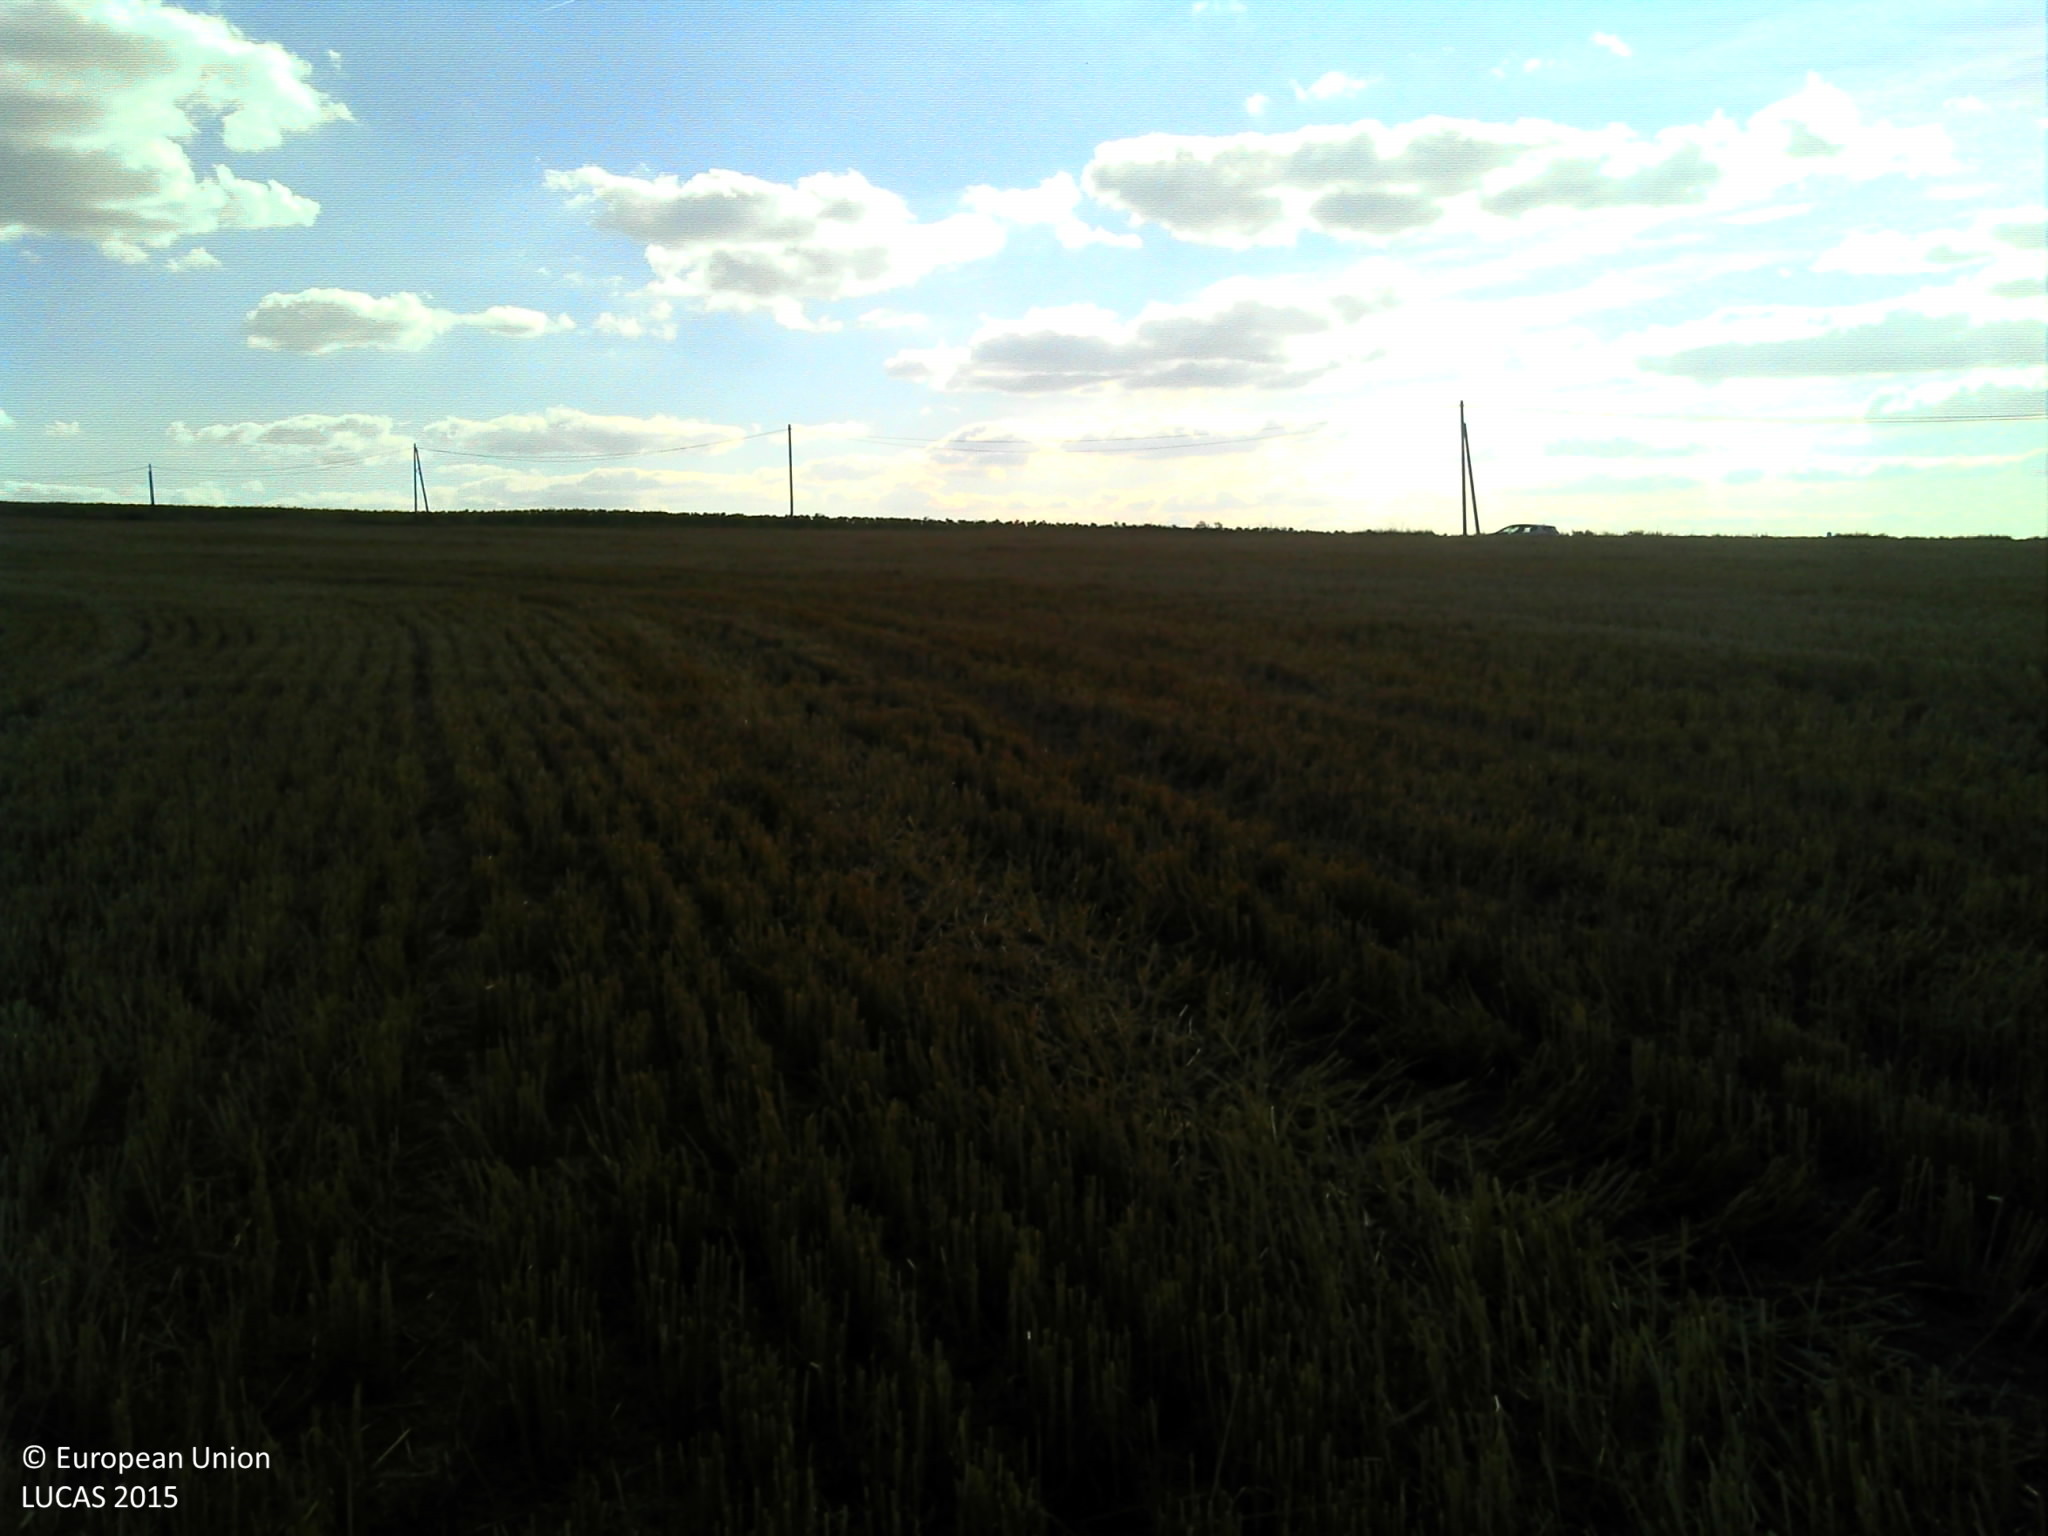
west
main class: Cropland
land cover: Common wheat
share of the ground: > 75 %
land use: Agriculture (excluding fallow land and kitchen gardens)
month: July
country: FR
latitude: 47.0821
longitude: 0.8553
